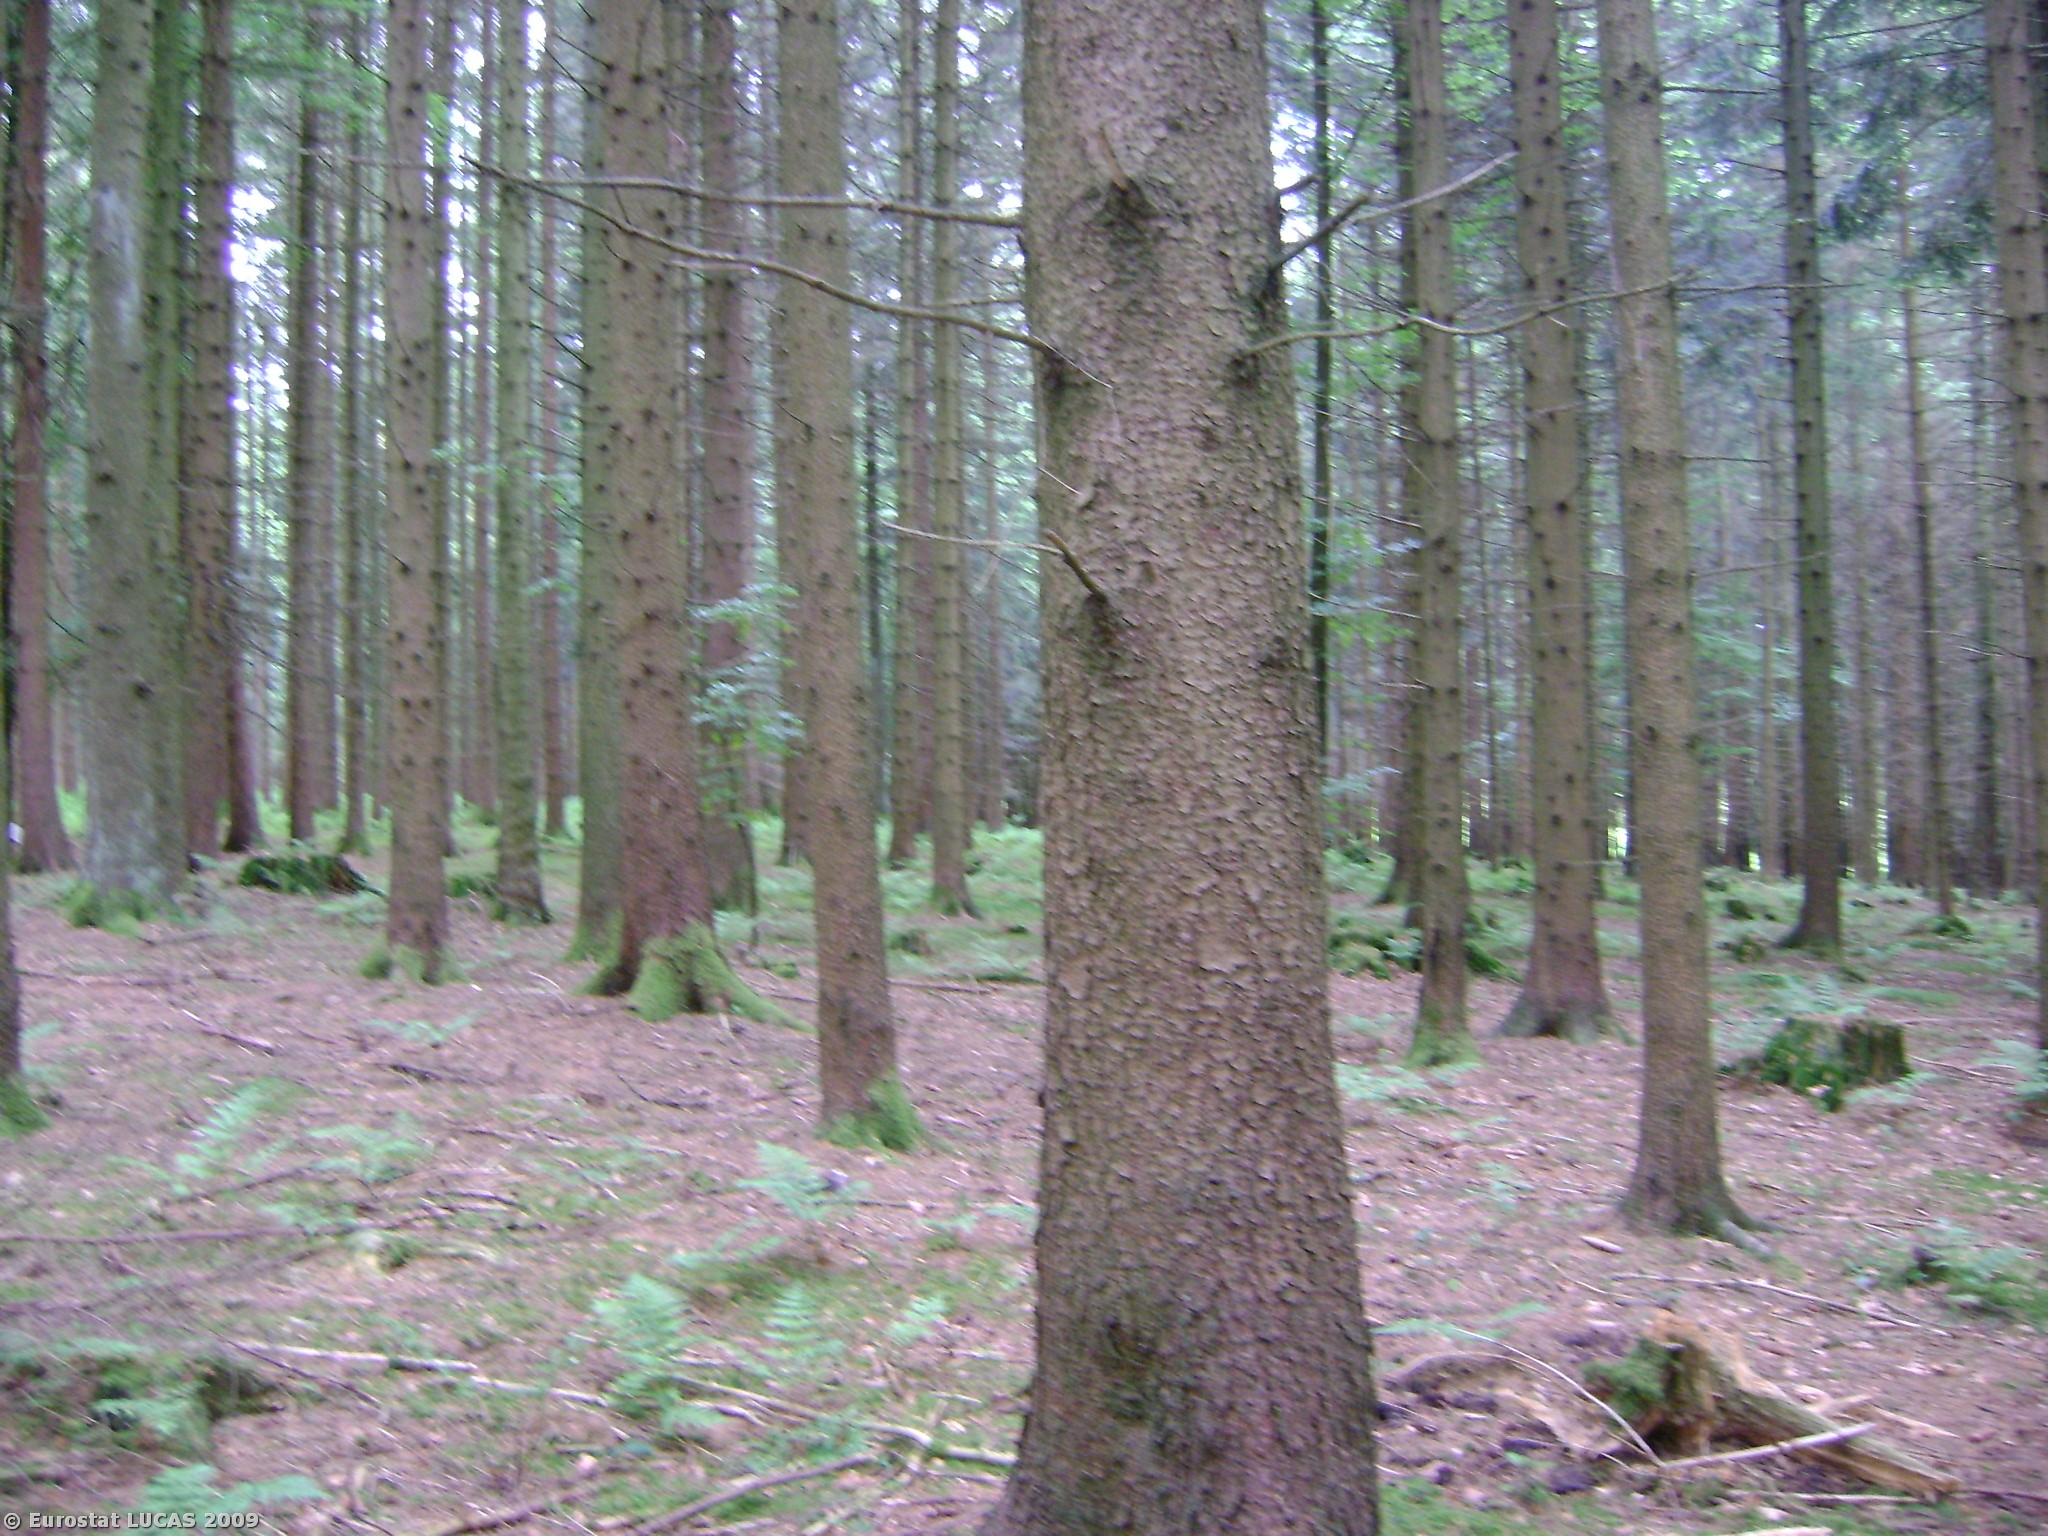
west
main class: Woodland
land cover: Coniferous woodland
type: hemiboreal forest and nemoral coniferous forest and mixed broadleaved-coniferous forest
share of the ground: > 75 %
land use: Forestry
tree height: > 5 m
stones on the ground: < 10 %
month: May
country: AT
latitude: 47.9758
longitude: 13.3078
